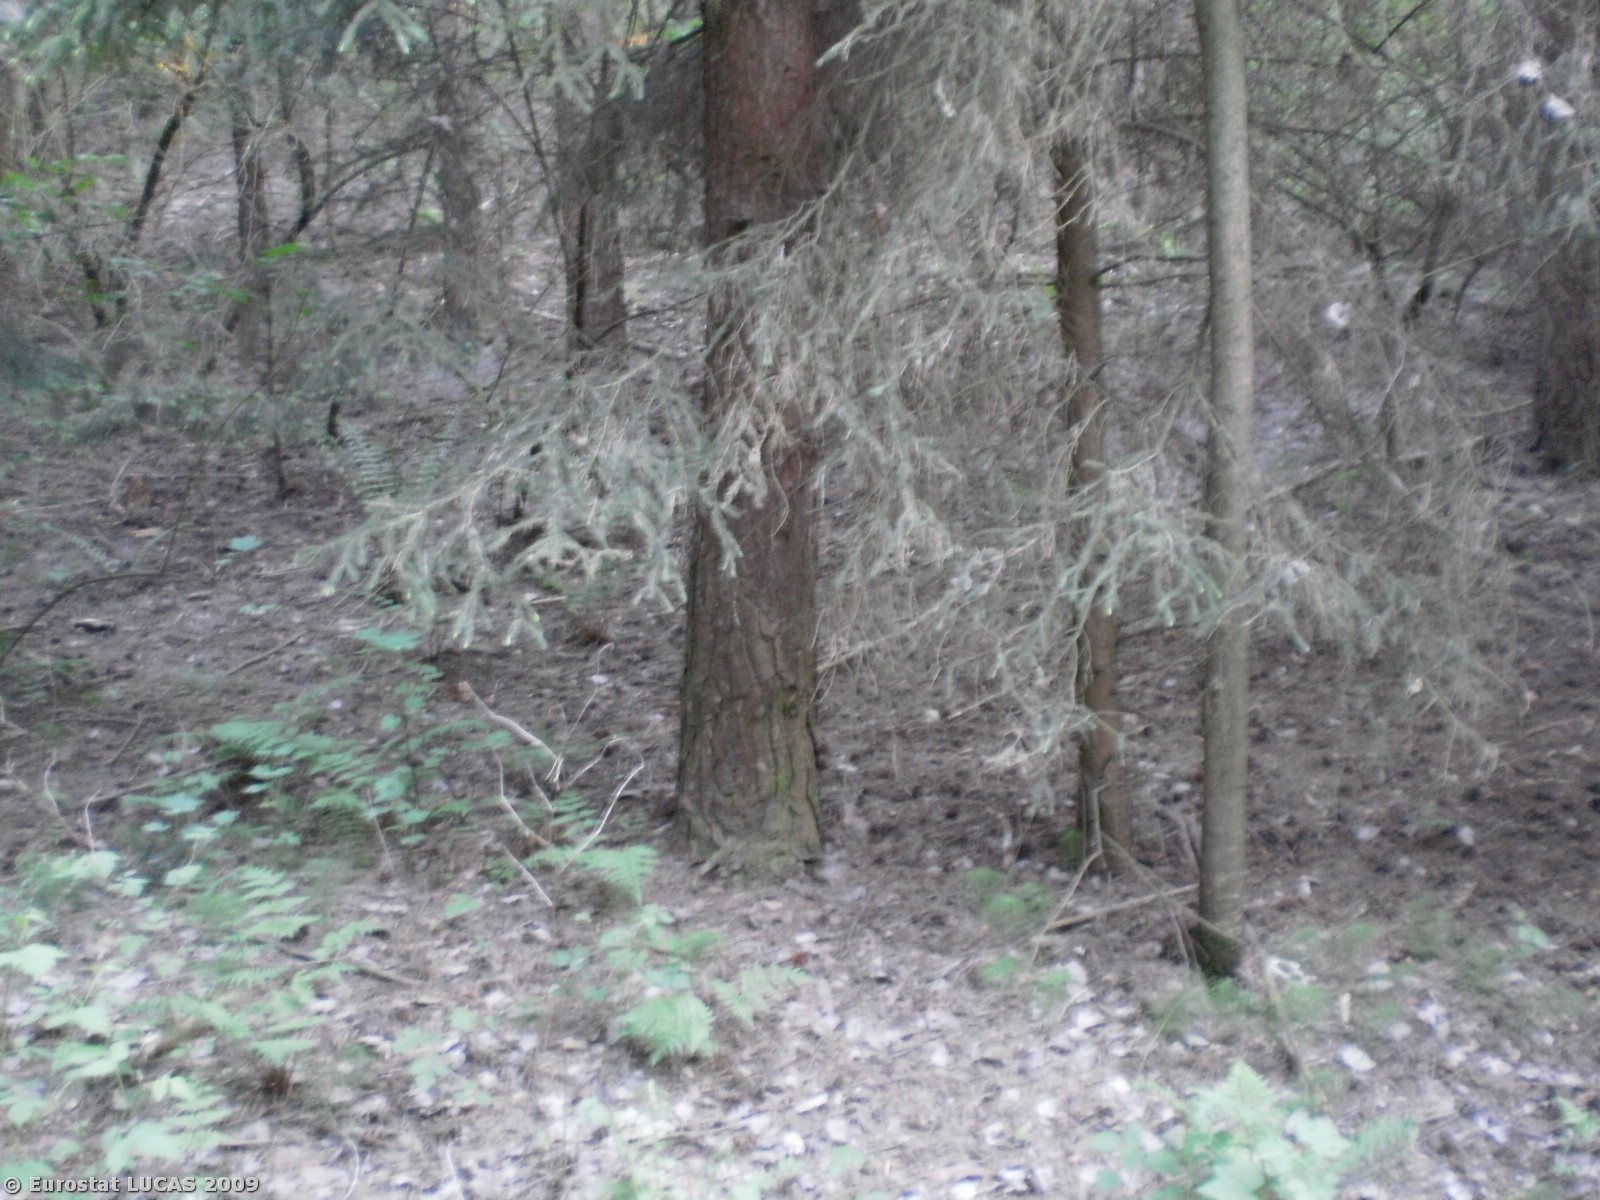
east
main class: Woodland
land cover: Coniferous woodland
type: hemiboreal forest and nemoral coniferous forest and mixed broadleaved-coniferous forest
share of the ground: < 10 %
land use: Forestry
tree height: > 5 m
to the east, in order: Coniferous woodland; Tracks; Coniferous woodland; Common wheat
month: May
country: PL
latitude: 53.4230
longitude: 18.8241
